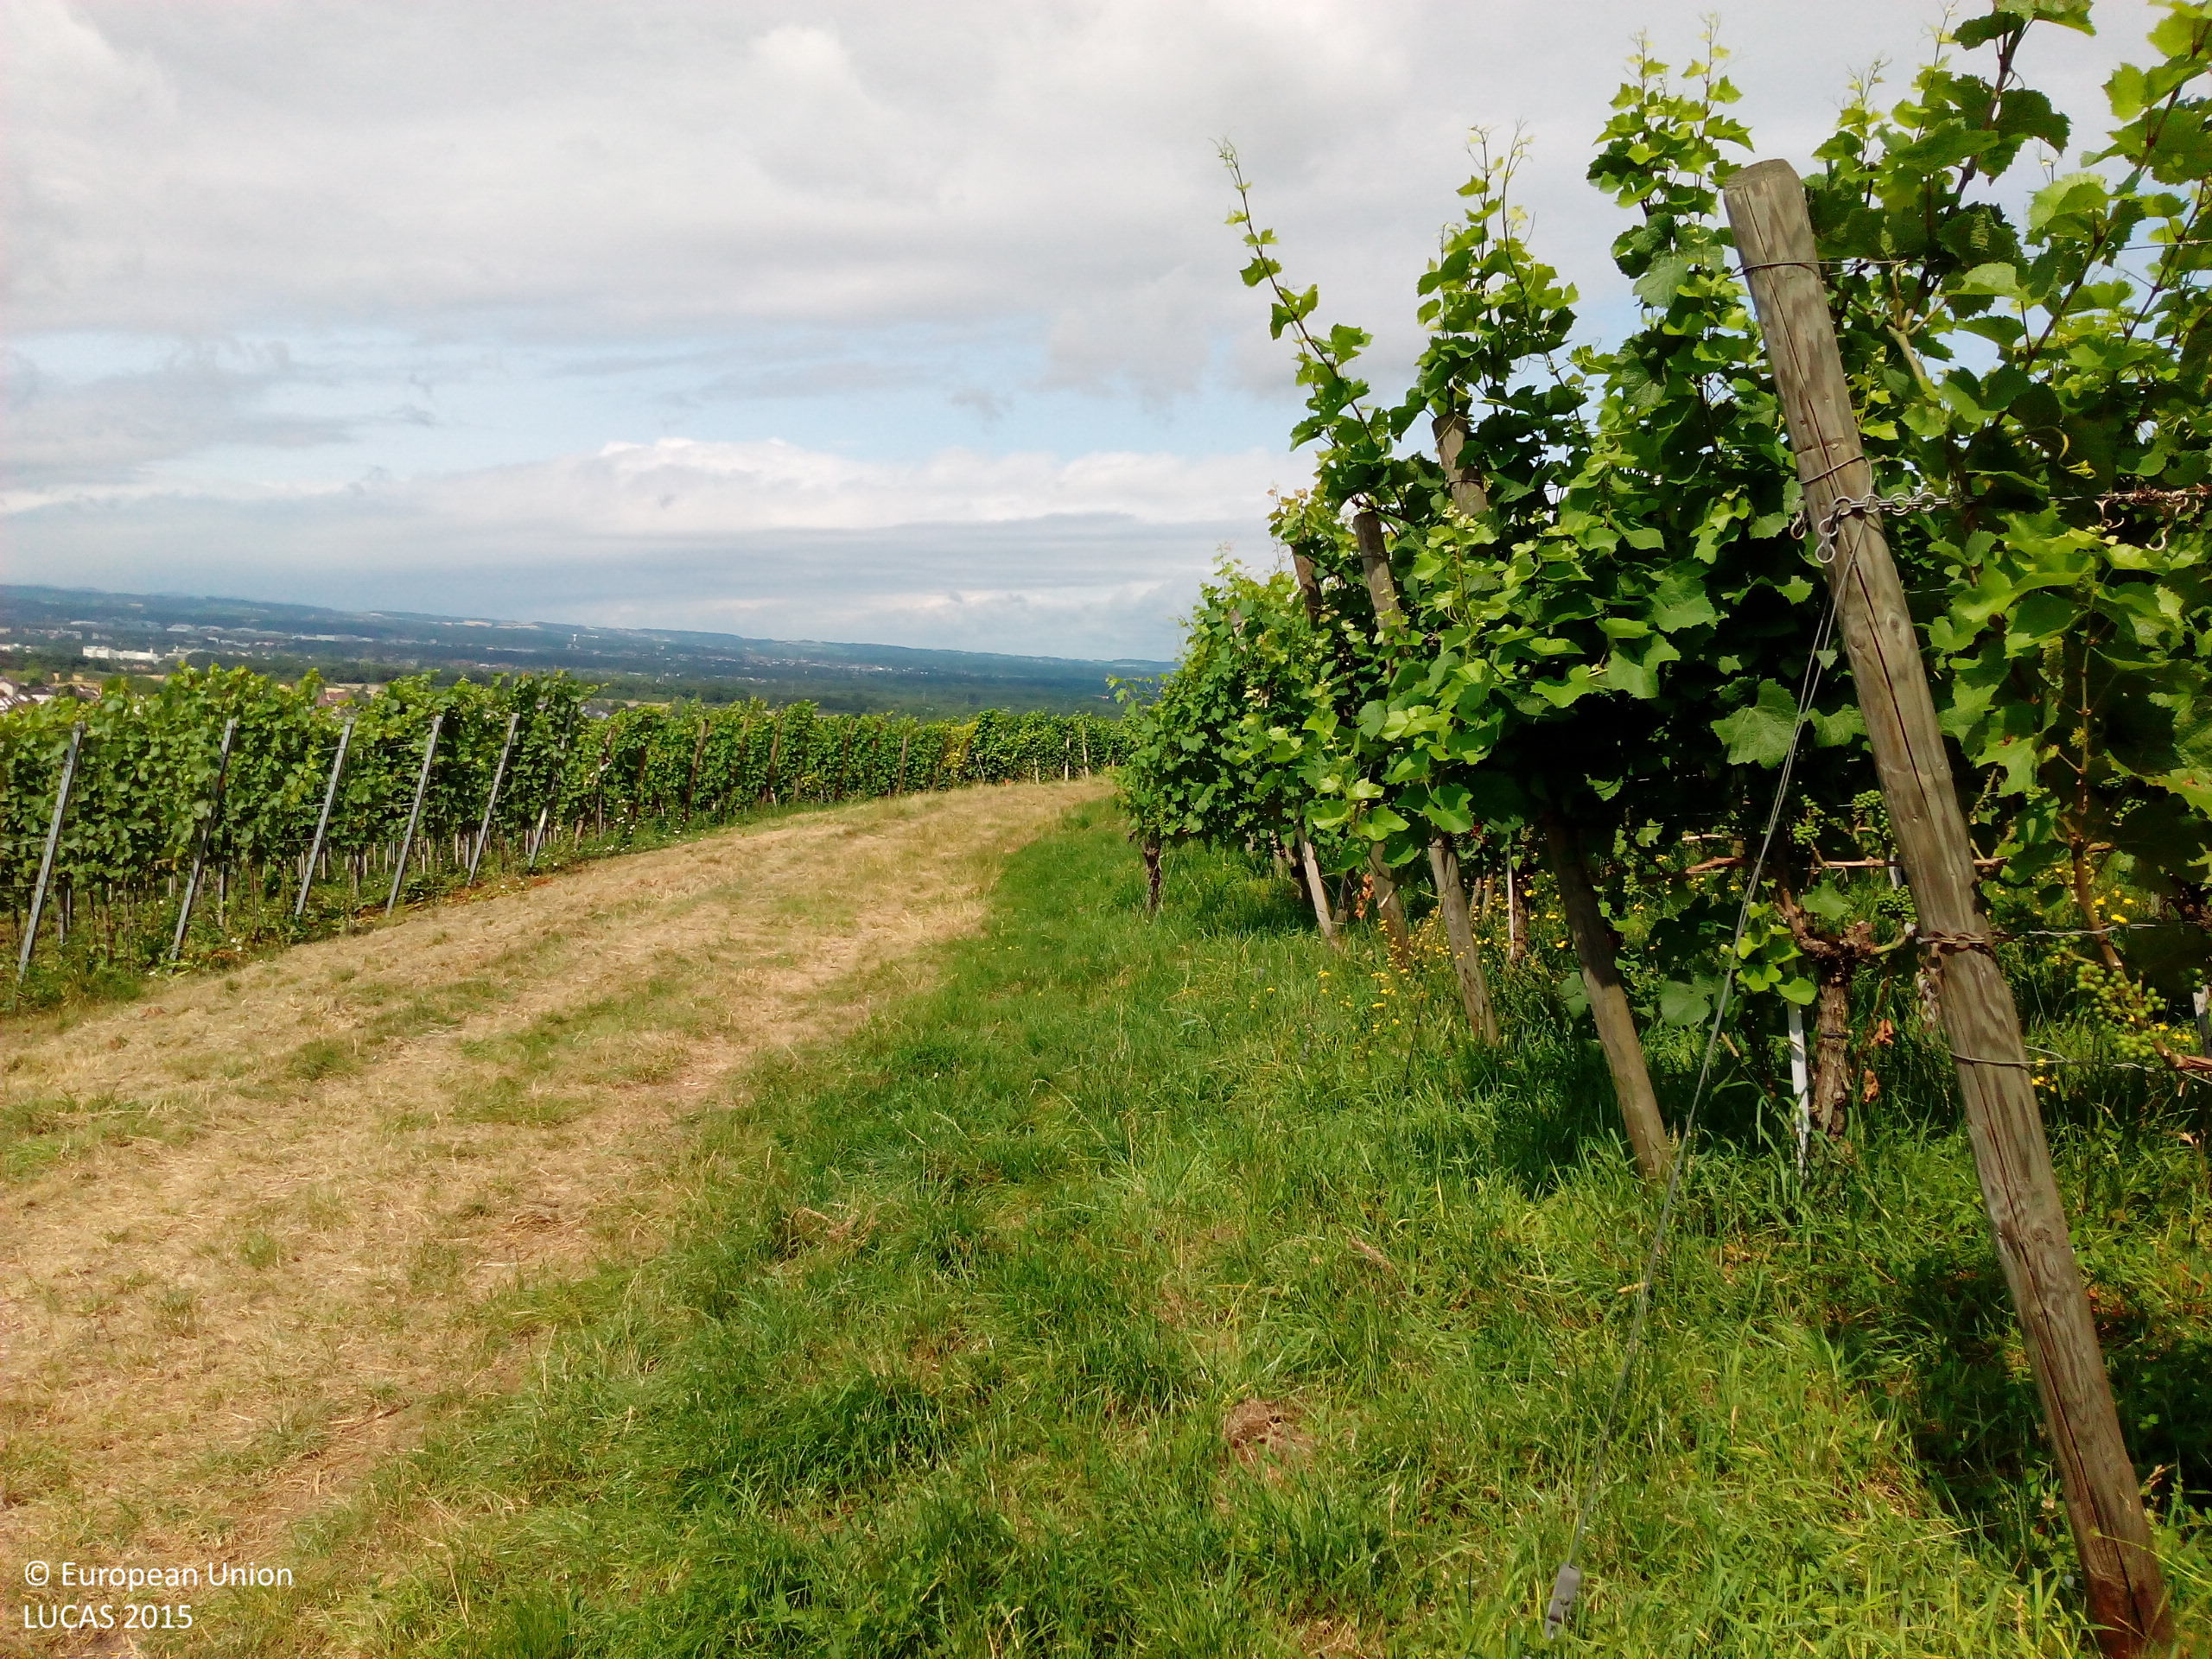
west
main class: Cropland
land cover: Vineyards
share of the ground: 25 - 50 %
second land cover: Grassland without tree/shrub cover
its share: 50 - 75 %
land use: Agriculture (excluding fallow land and kitchen gardens)
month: July
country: DE
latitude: 47.6217
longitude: 7.6198
